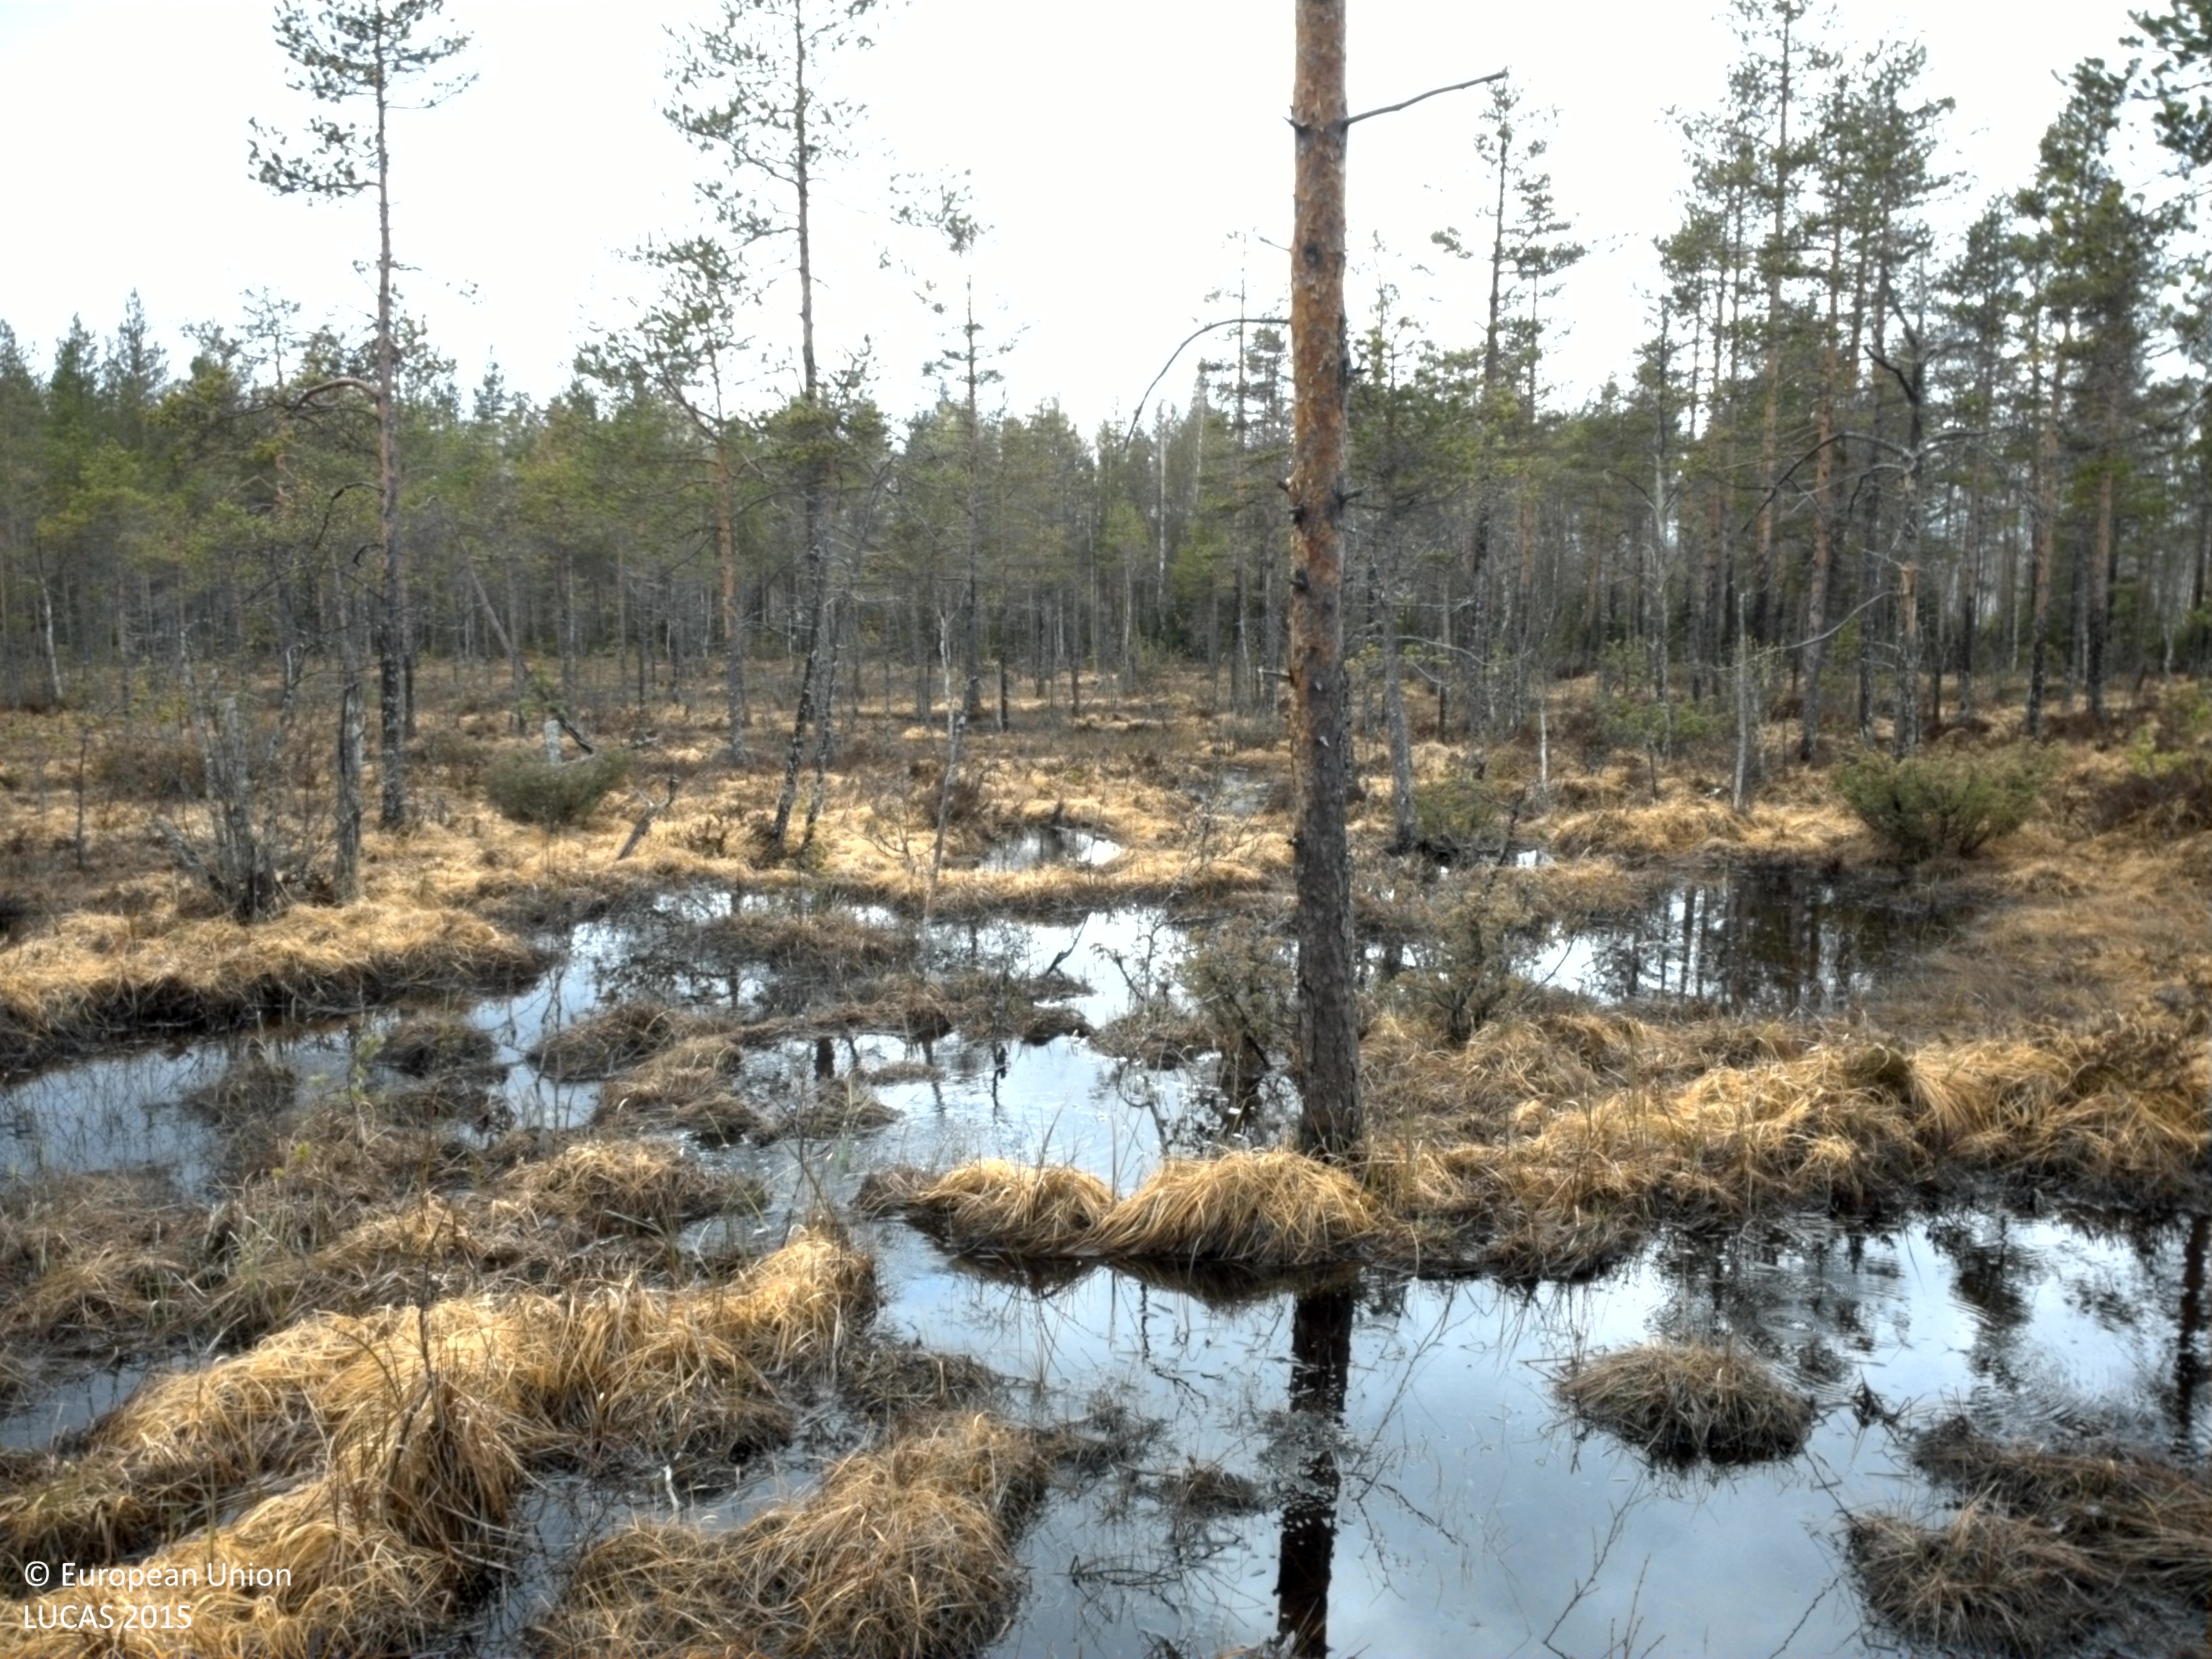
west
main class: Woodland
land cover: Pine dominated coniferous woodland
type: mire and swamp forests
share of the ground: 25 - 50 %
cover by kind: herbaceous plants 45 %, coniferous forest trees 35 %, shrubs 15 %, broadleaved forest trees 5 %
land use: Semi-natural and natural areas not in use
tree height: > 5 m
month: May
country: SE
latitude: 66.2117
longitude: 23.2485
